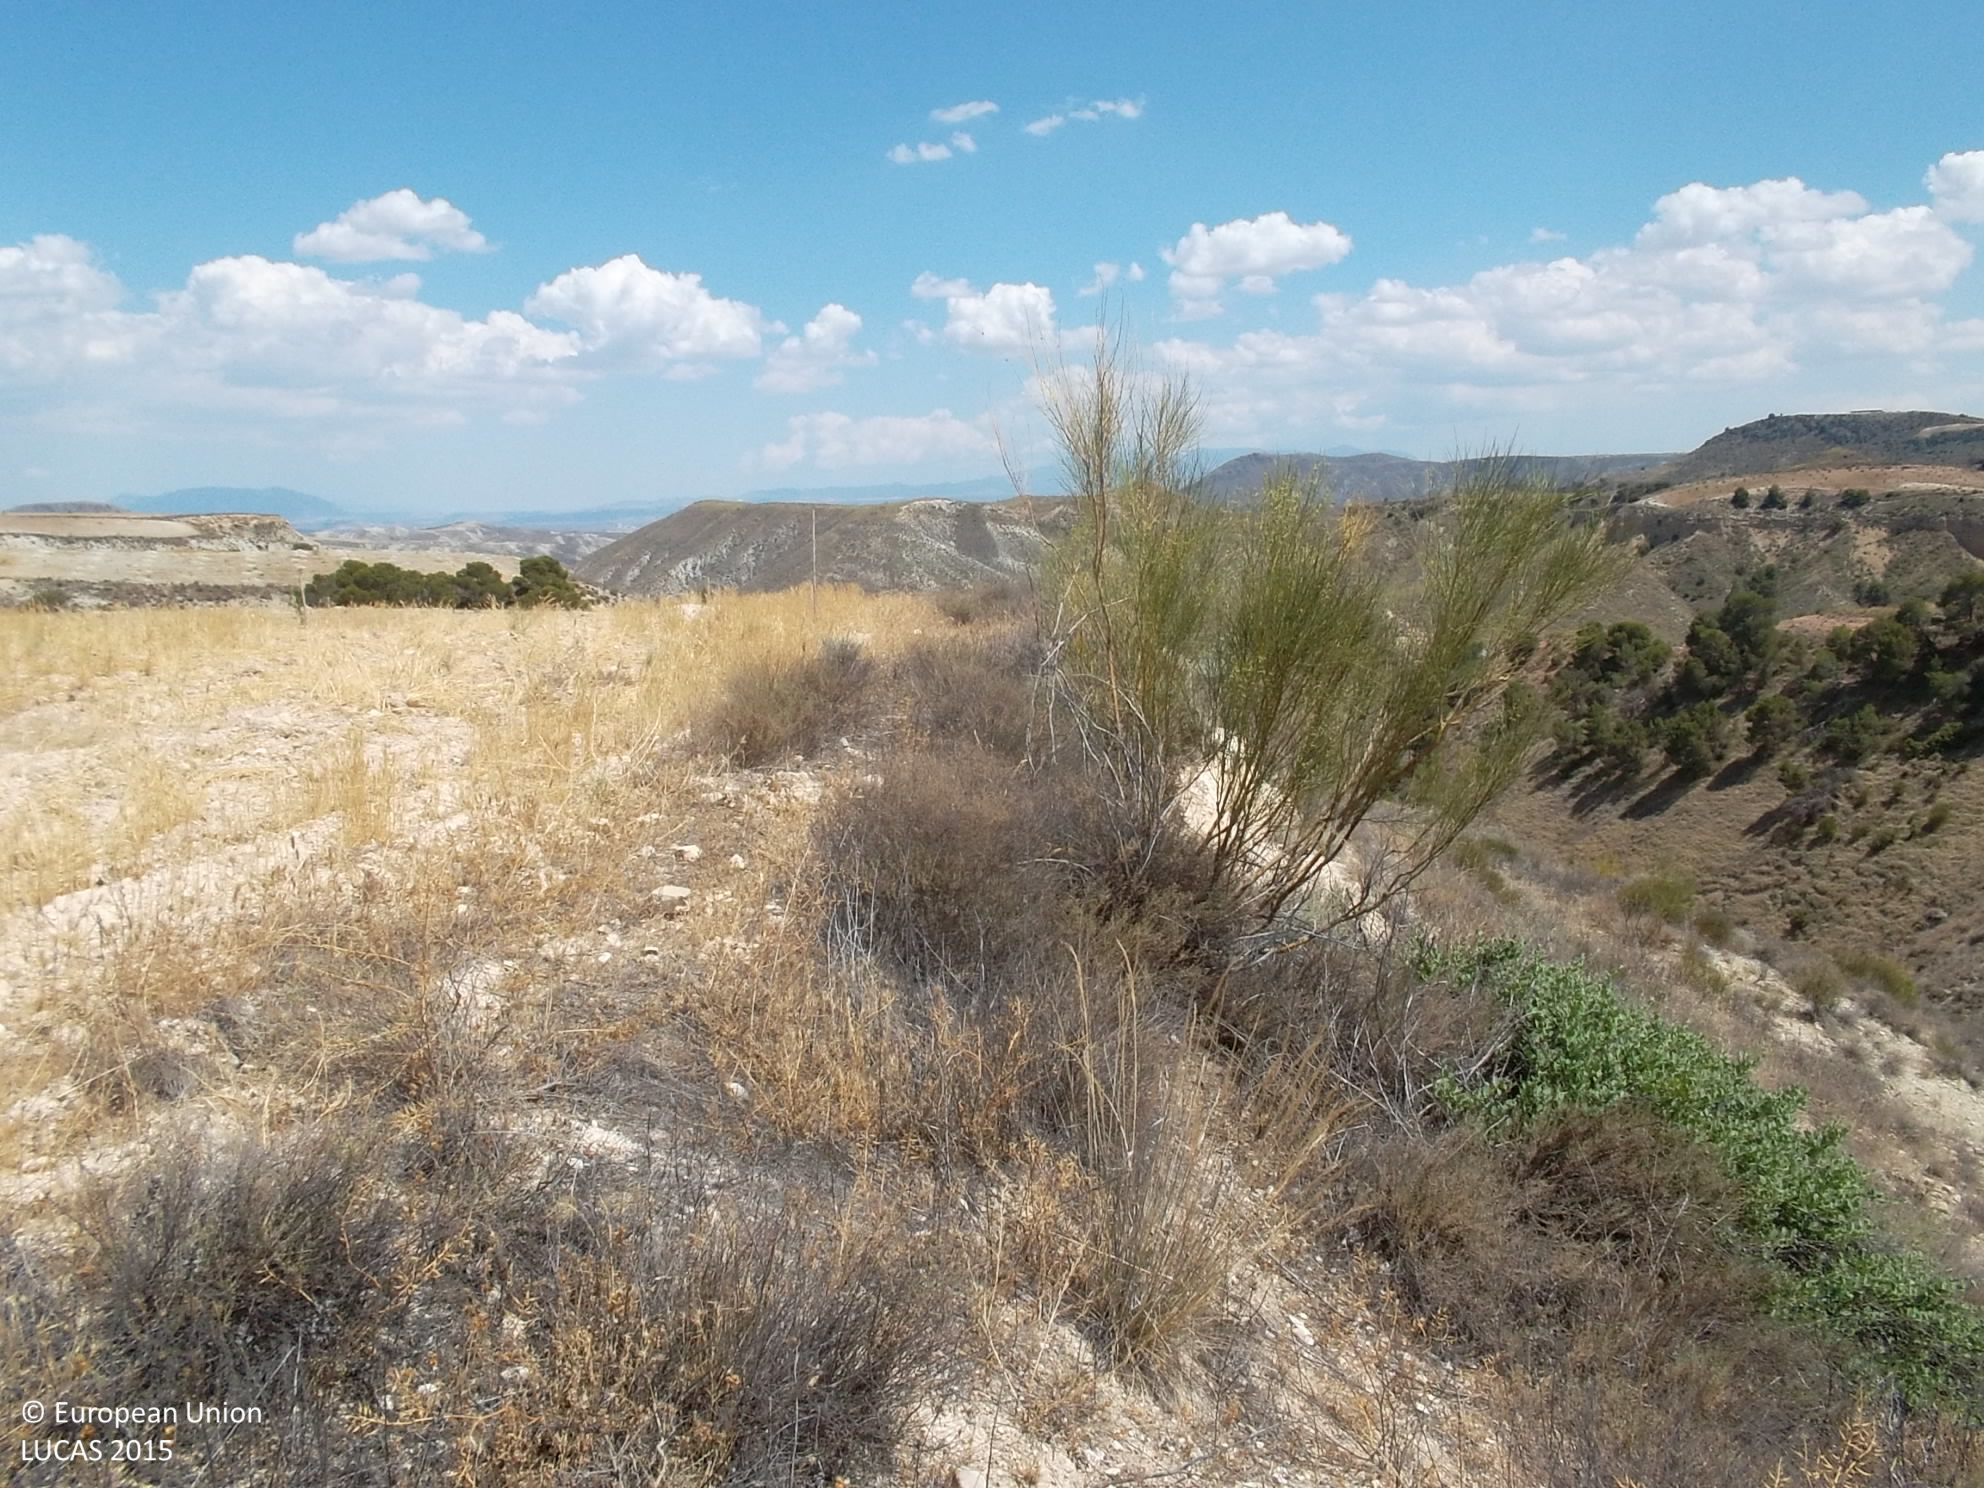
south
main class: Grassland
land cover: Grassland with sparse tree/shrub cover
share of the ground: > 75 %
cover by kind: herbaceous plants 85 %, shrubs 10 %, broadleaved forest trees 5 %
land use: Semi-natural and natural areas not in use
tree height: < 5 m
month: June
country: ES
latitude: 37.6490
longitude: -3.1972
